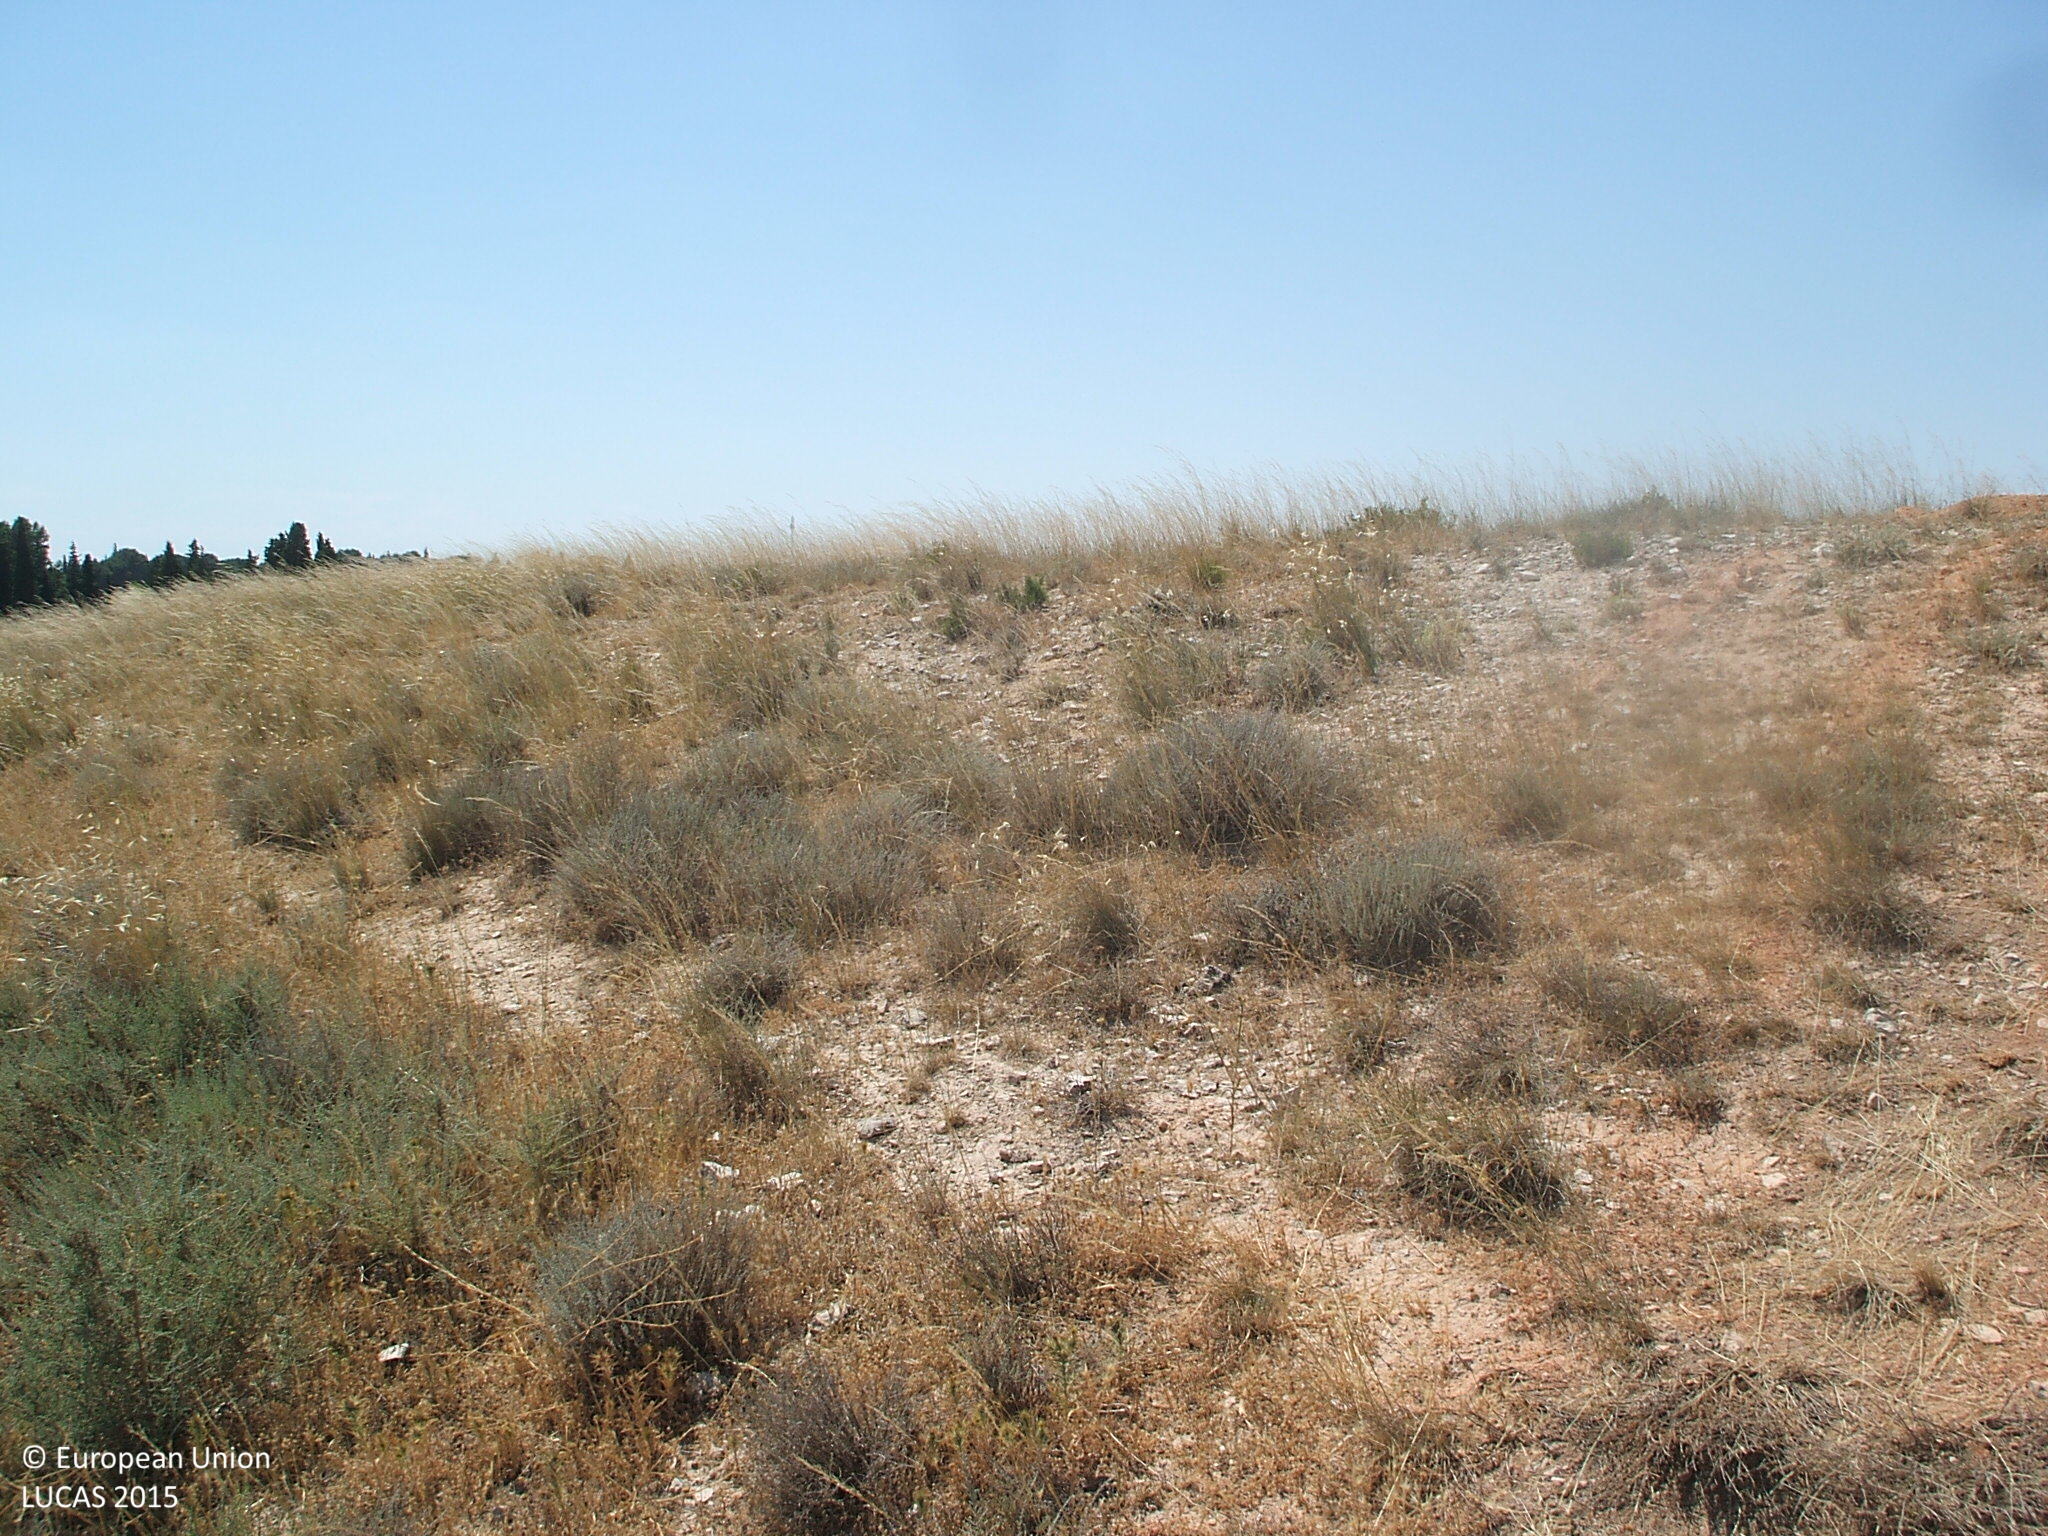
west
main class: Shrubland
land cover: Shrubland without tree cover
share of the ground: 50 - 75 %
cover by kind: shrubs 50 %, herbaceous plants 30 %, consolidated bare surface 20 %
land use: Semi-natural and natural areas not in use
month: June
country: ES
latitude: 41.1168
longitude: -0.2189
